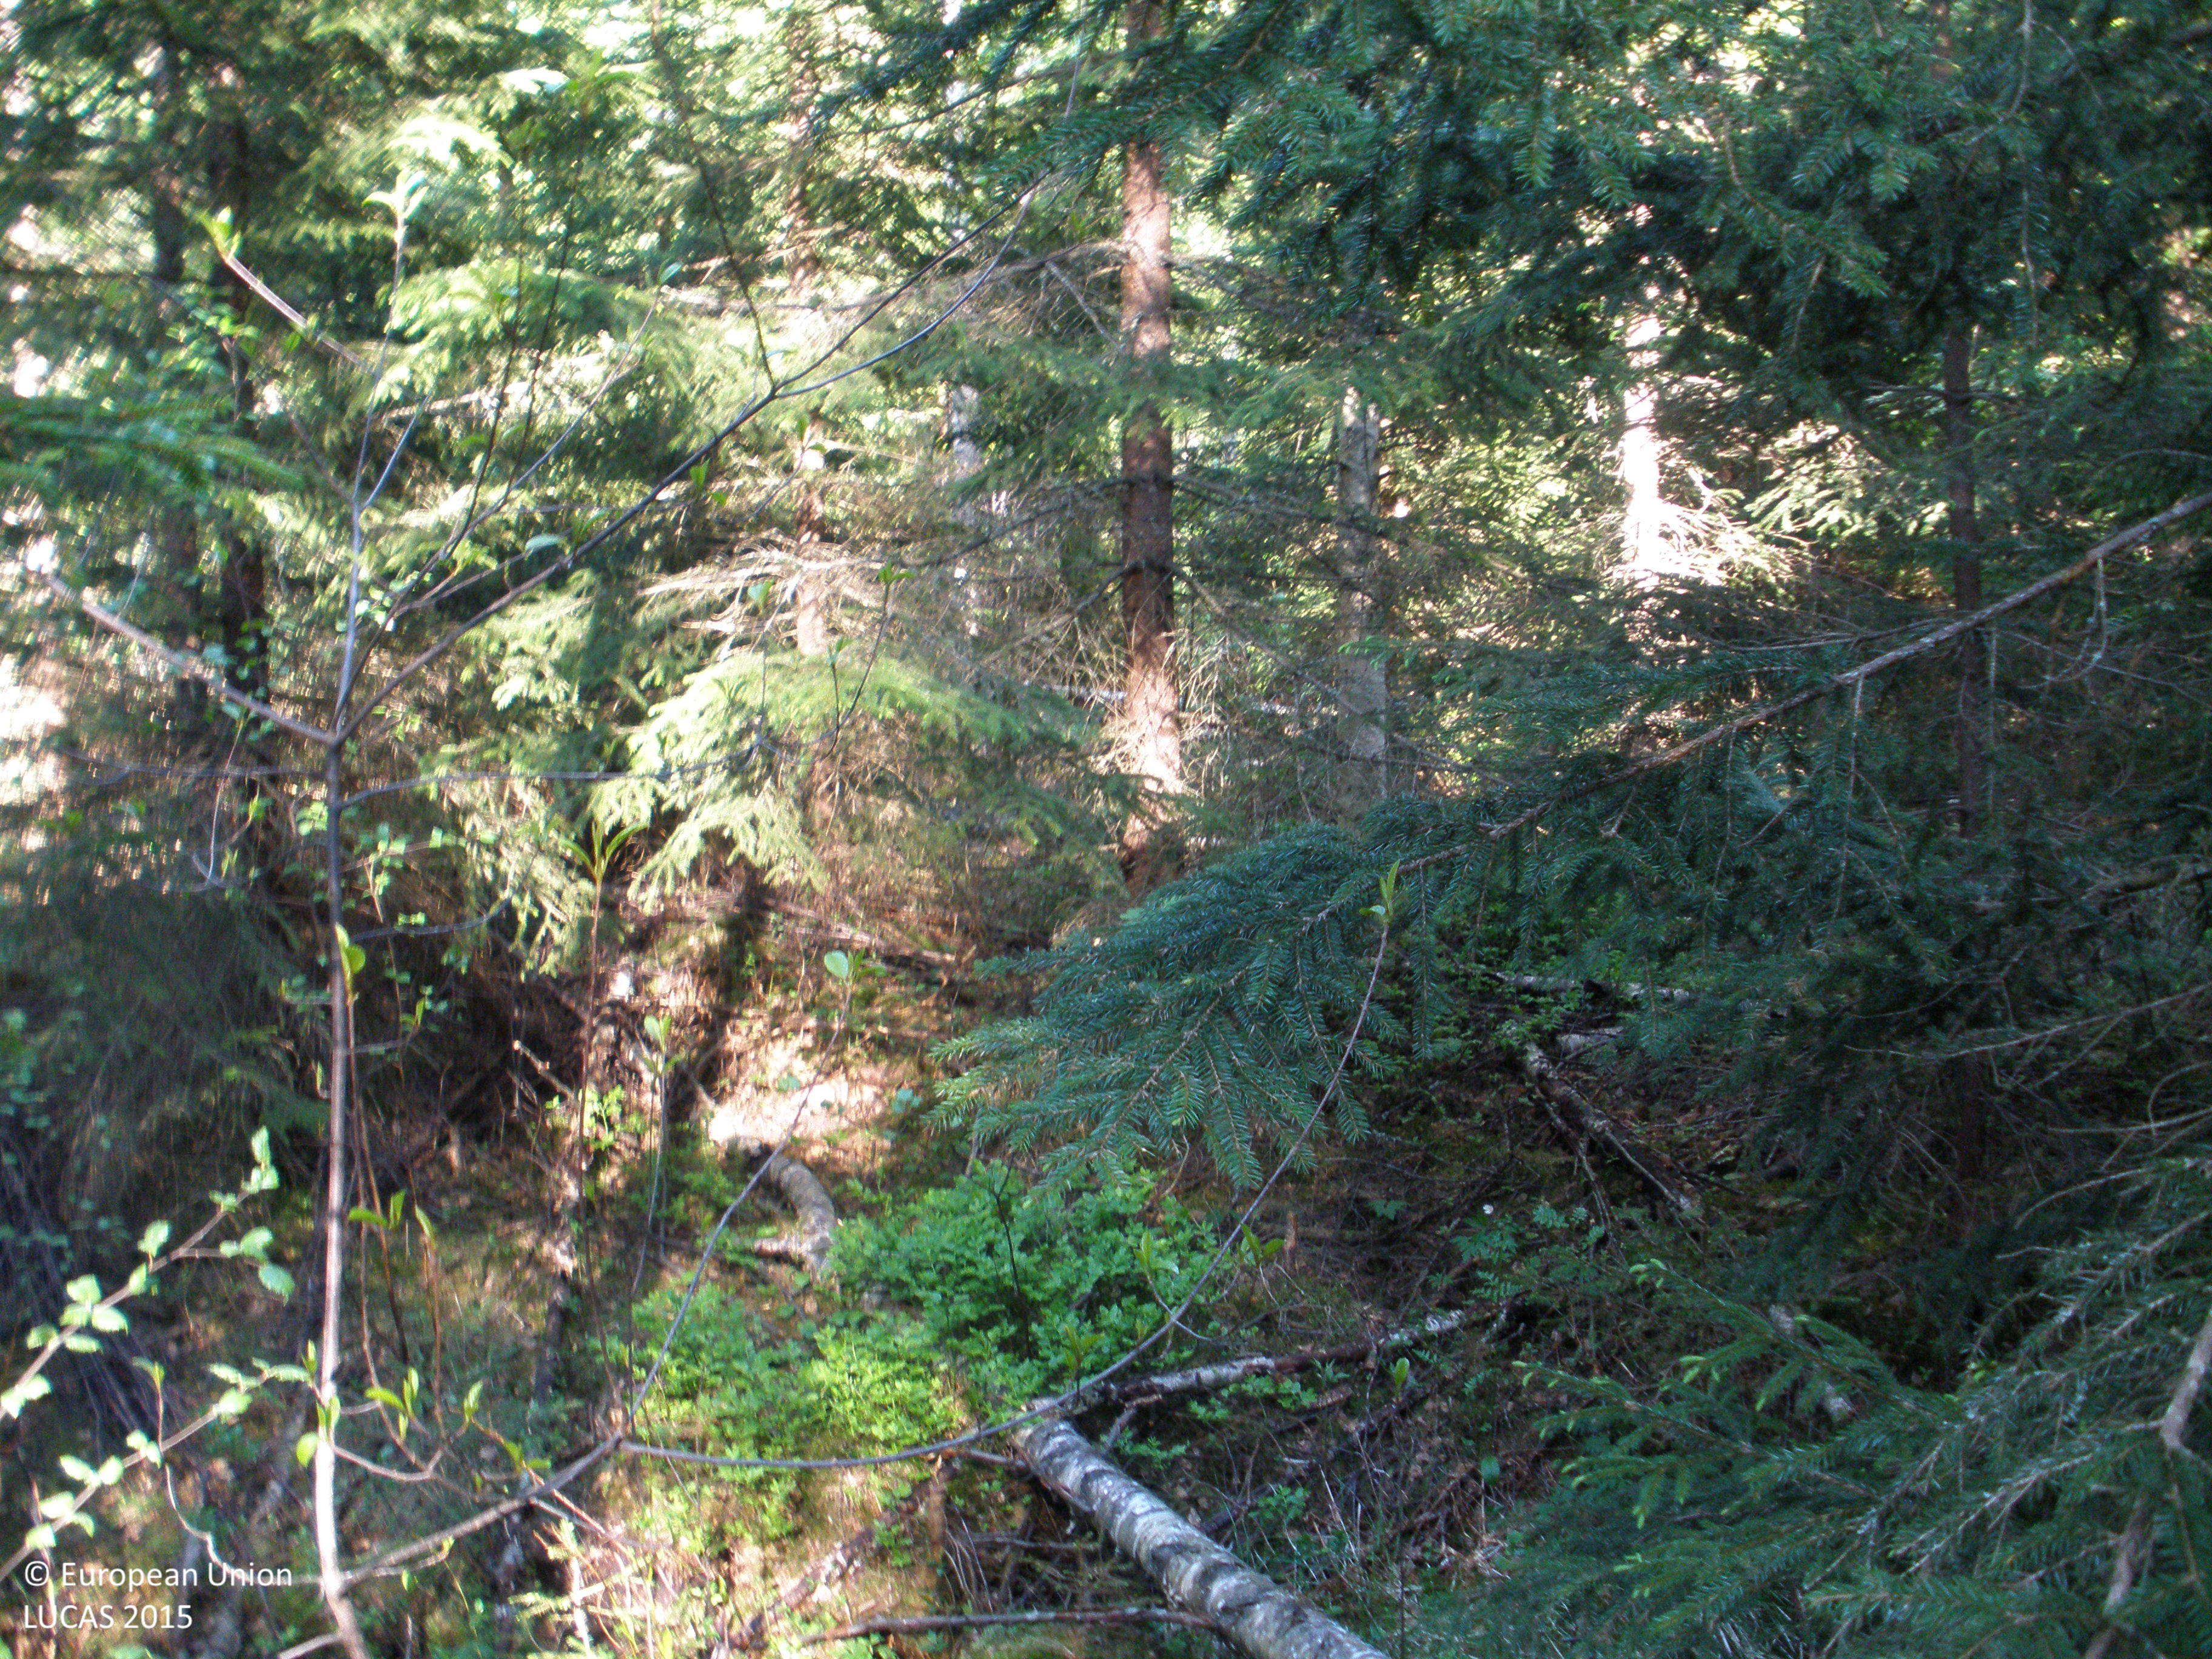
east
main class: Woodland
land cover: Spruce dominated coniferous woodland
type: boreal forest
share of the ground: > 75 %
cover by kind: coniferous forest trees 80 %, broadleaved forest trees 10 %, herbaceous plants 10 %
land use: Forestry
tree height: > 5 m
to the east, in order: Spruce dominated coniferous woodland; Pine dominated coniferous woodland; Paved roads, cycling and walking lanes; Electric lines; Other mixed woodland; Pine dominated coniferous woodland
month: June
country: FI
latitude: 60.7690
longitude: 24.1031
